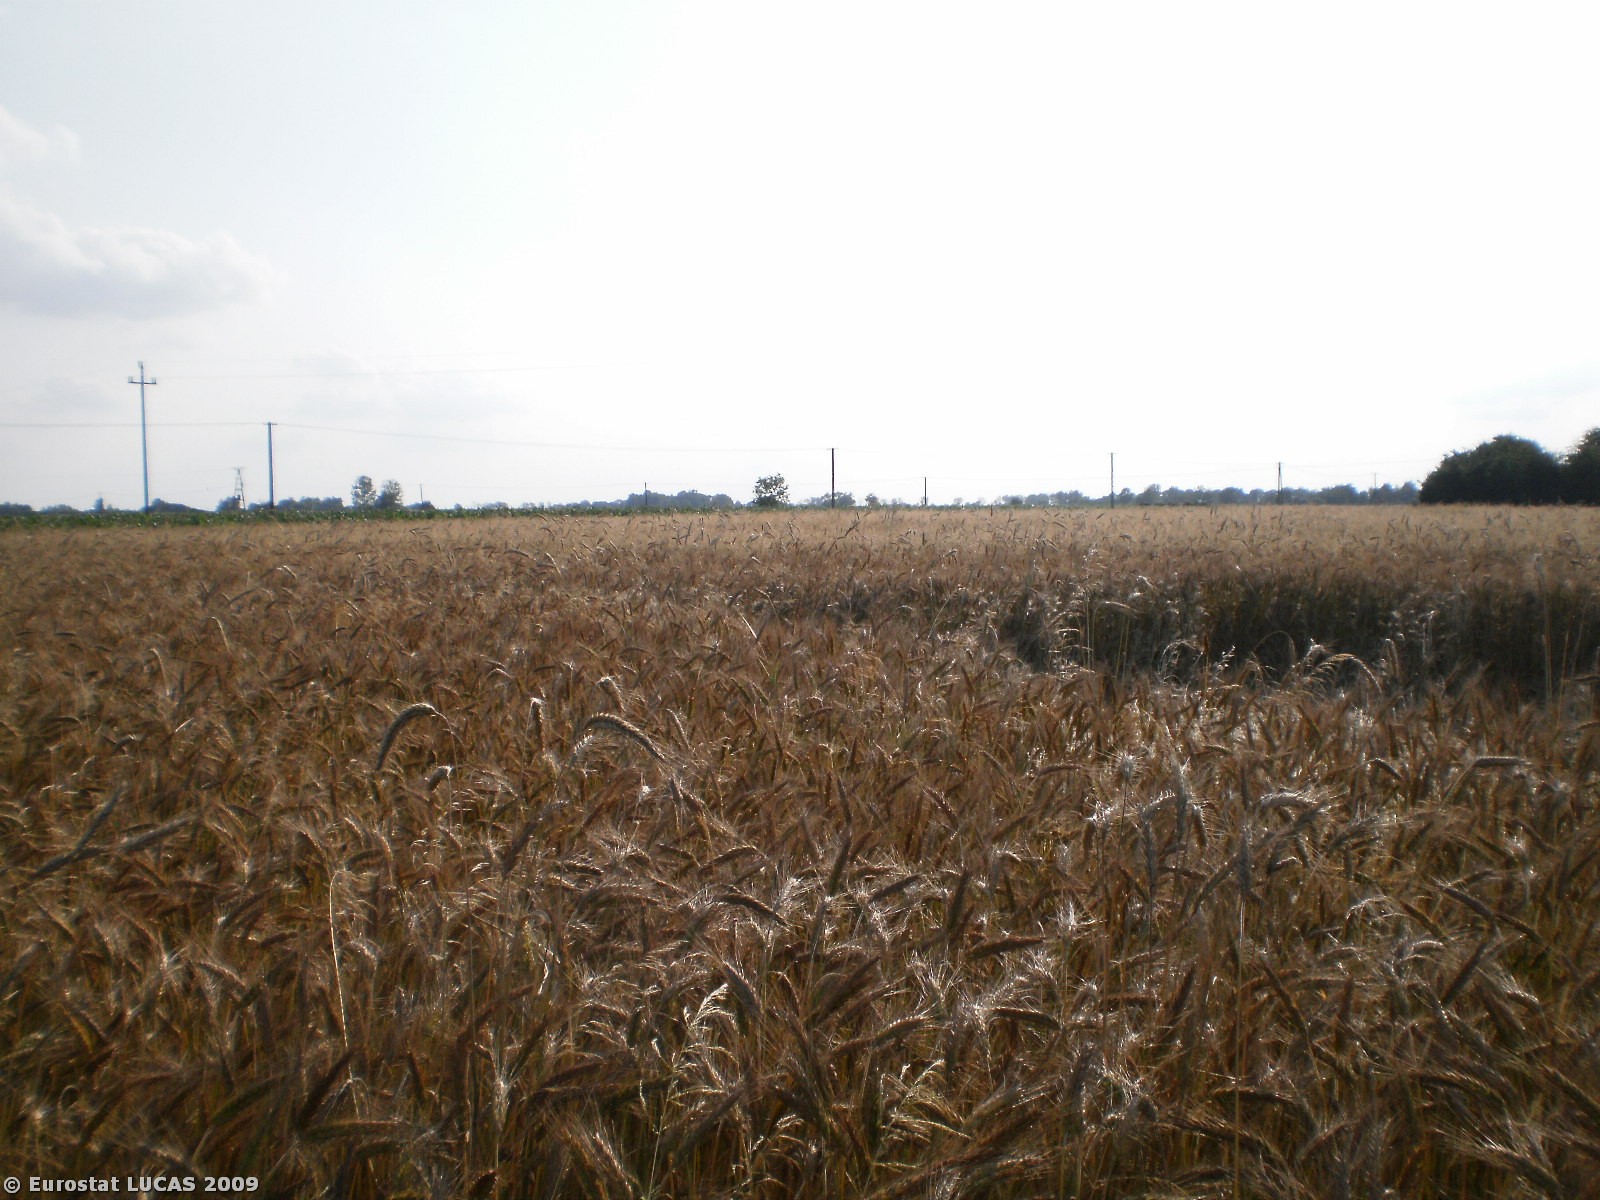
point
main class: Cropland
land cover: Triticale
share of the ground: > 75 %
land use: Agriculture (excluding fallow land and kitchen gardens)
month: July
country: PL
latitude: 52.9631
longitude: 20.8958
